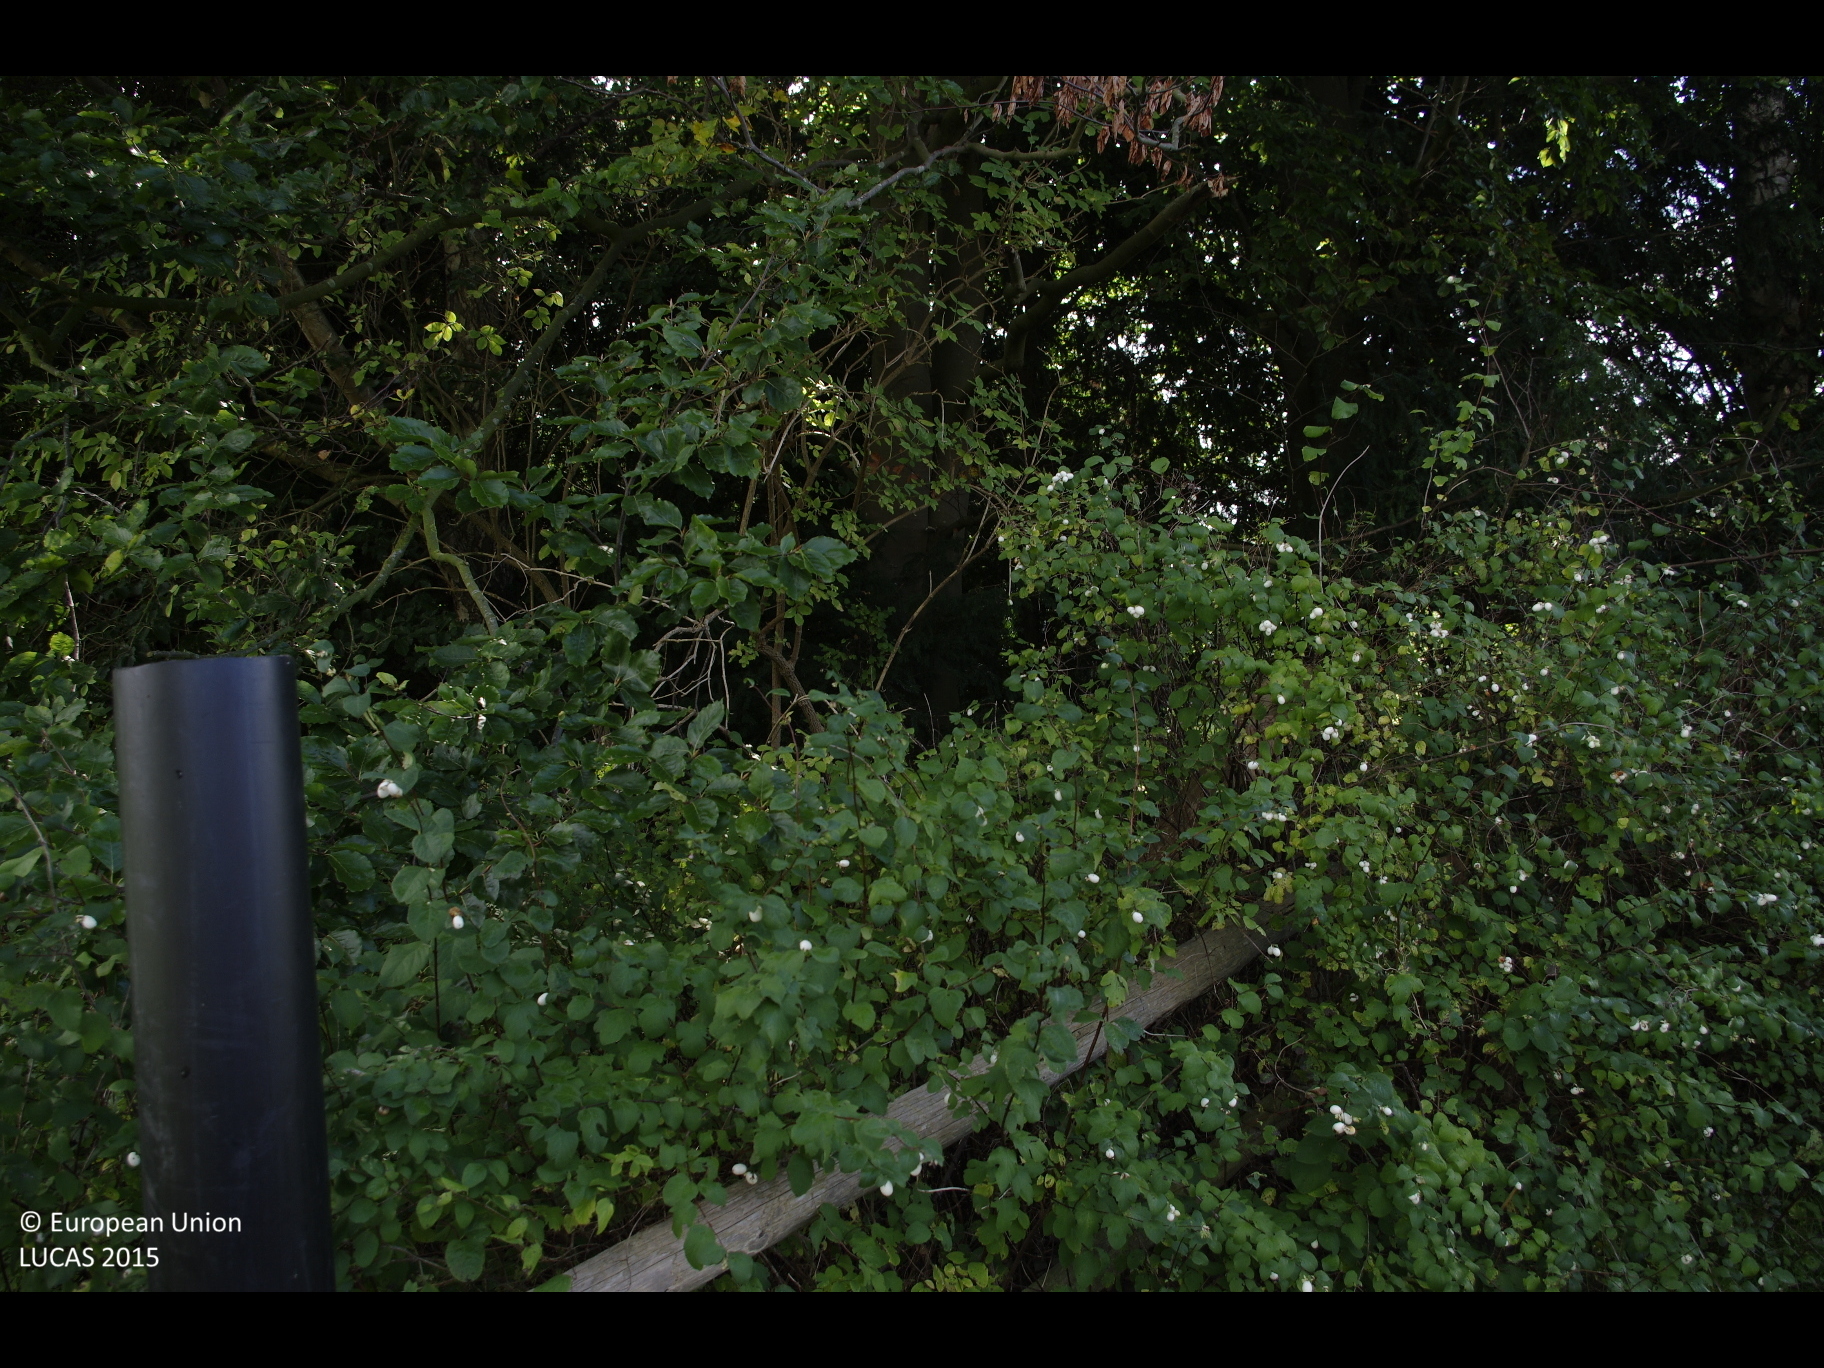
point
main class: Woodland
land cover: Other mixed woodland
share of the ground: > 75 %
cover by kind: coniferous forest trees 50 %, broadleaved forest trees 40 %, shrubs 10 %
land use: Residential
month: September
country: DE
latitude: 53.9934
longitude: 10.6250
